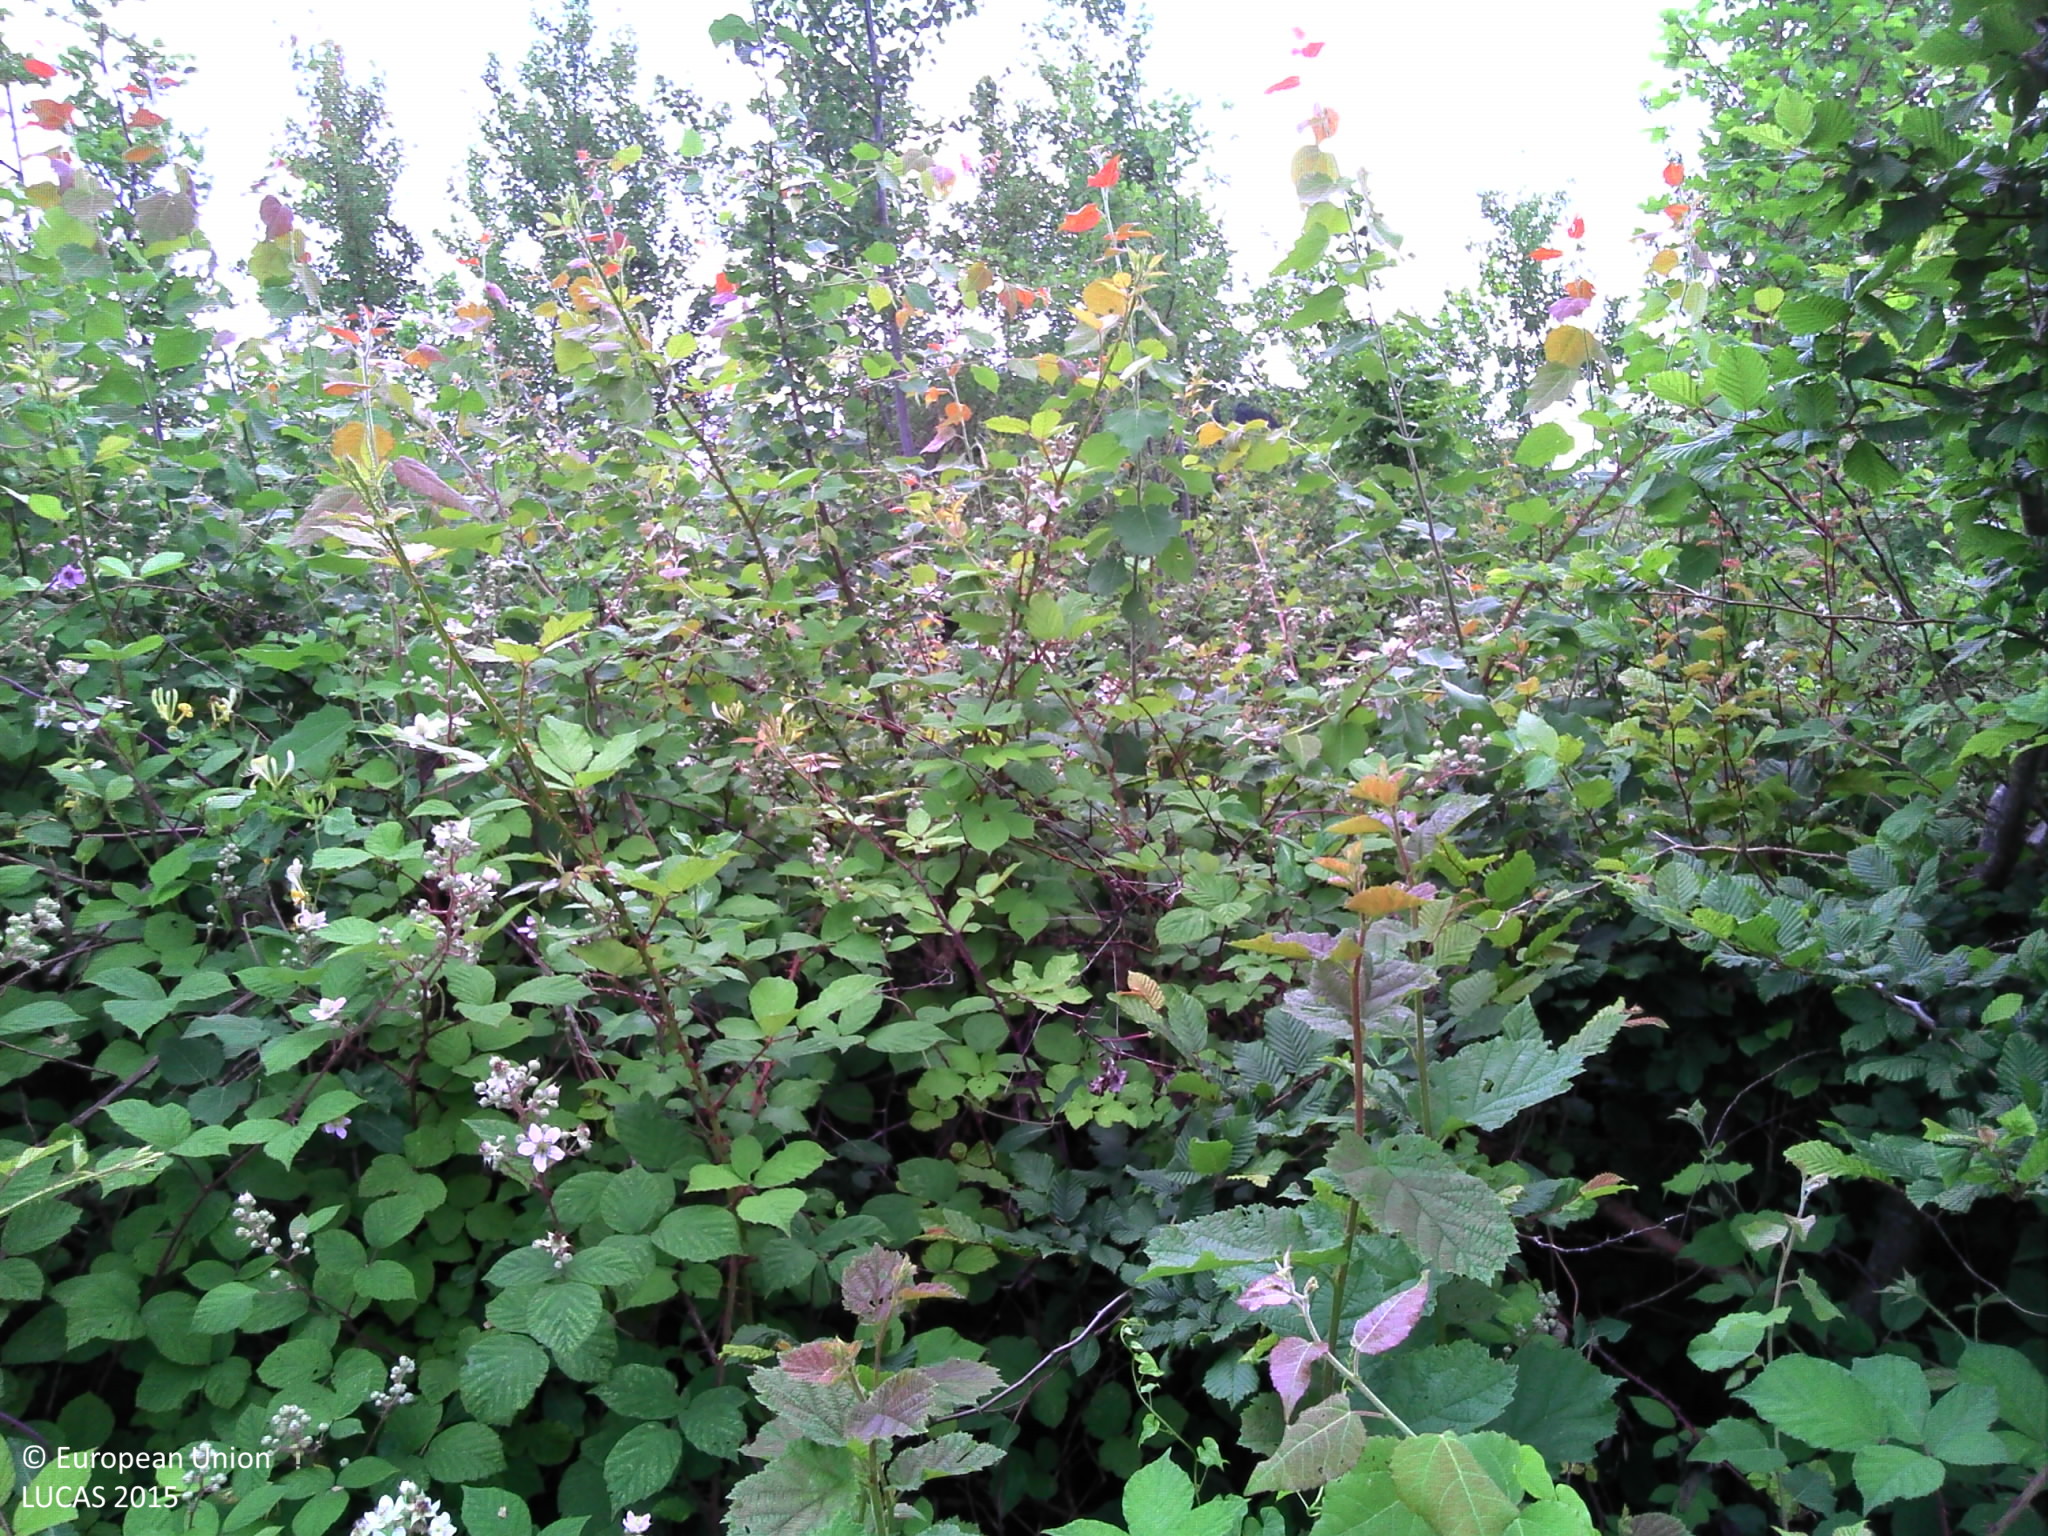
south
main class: Shrubland
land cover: Shrubland without tree cover
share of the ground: > 75 %
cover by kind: shrubs 70 %, herbaceous plants 30 %
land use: Semi-natural and natural areas not in use
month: June
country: FR
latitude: 43.7707
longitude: -0.2331
